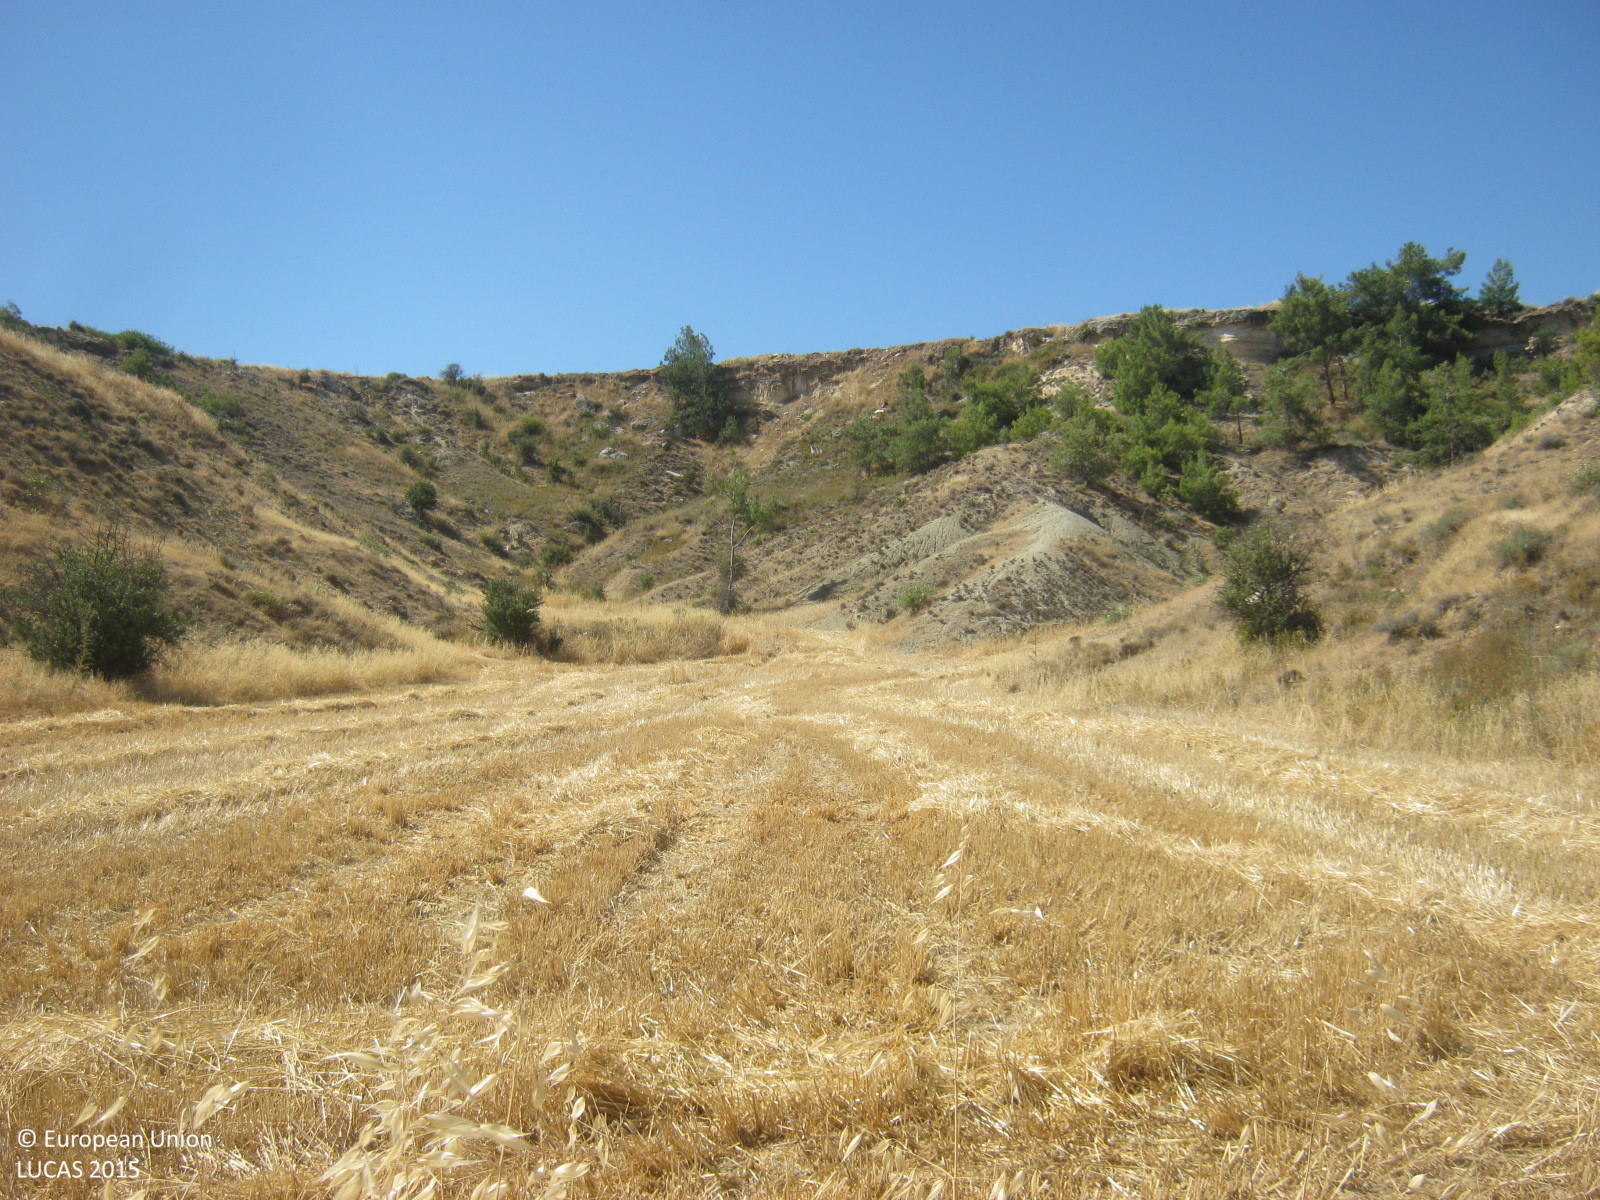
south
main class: Grassland
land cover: Spontaneously vegetated surfaces
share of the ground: > 75 %
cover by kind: herbaceous plants 85 %, unconsolidated bare surface 10 %, shrubs 5 %
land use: Semi-natural and natural areas not in use
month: June
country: CY
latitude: 35.0498
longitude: 33.1726
